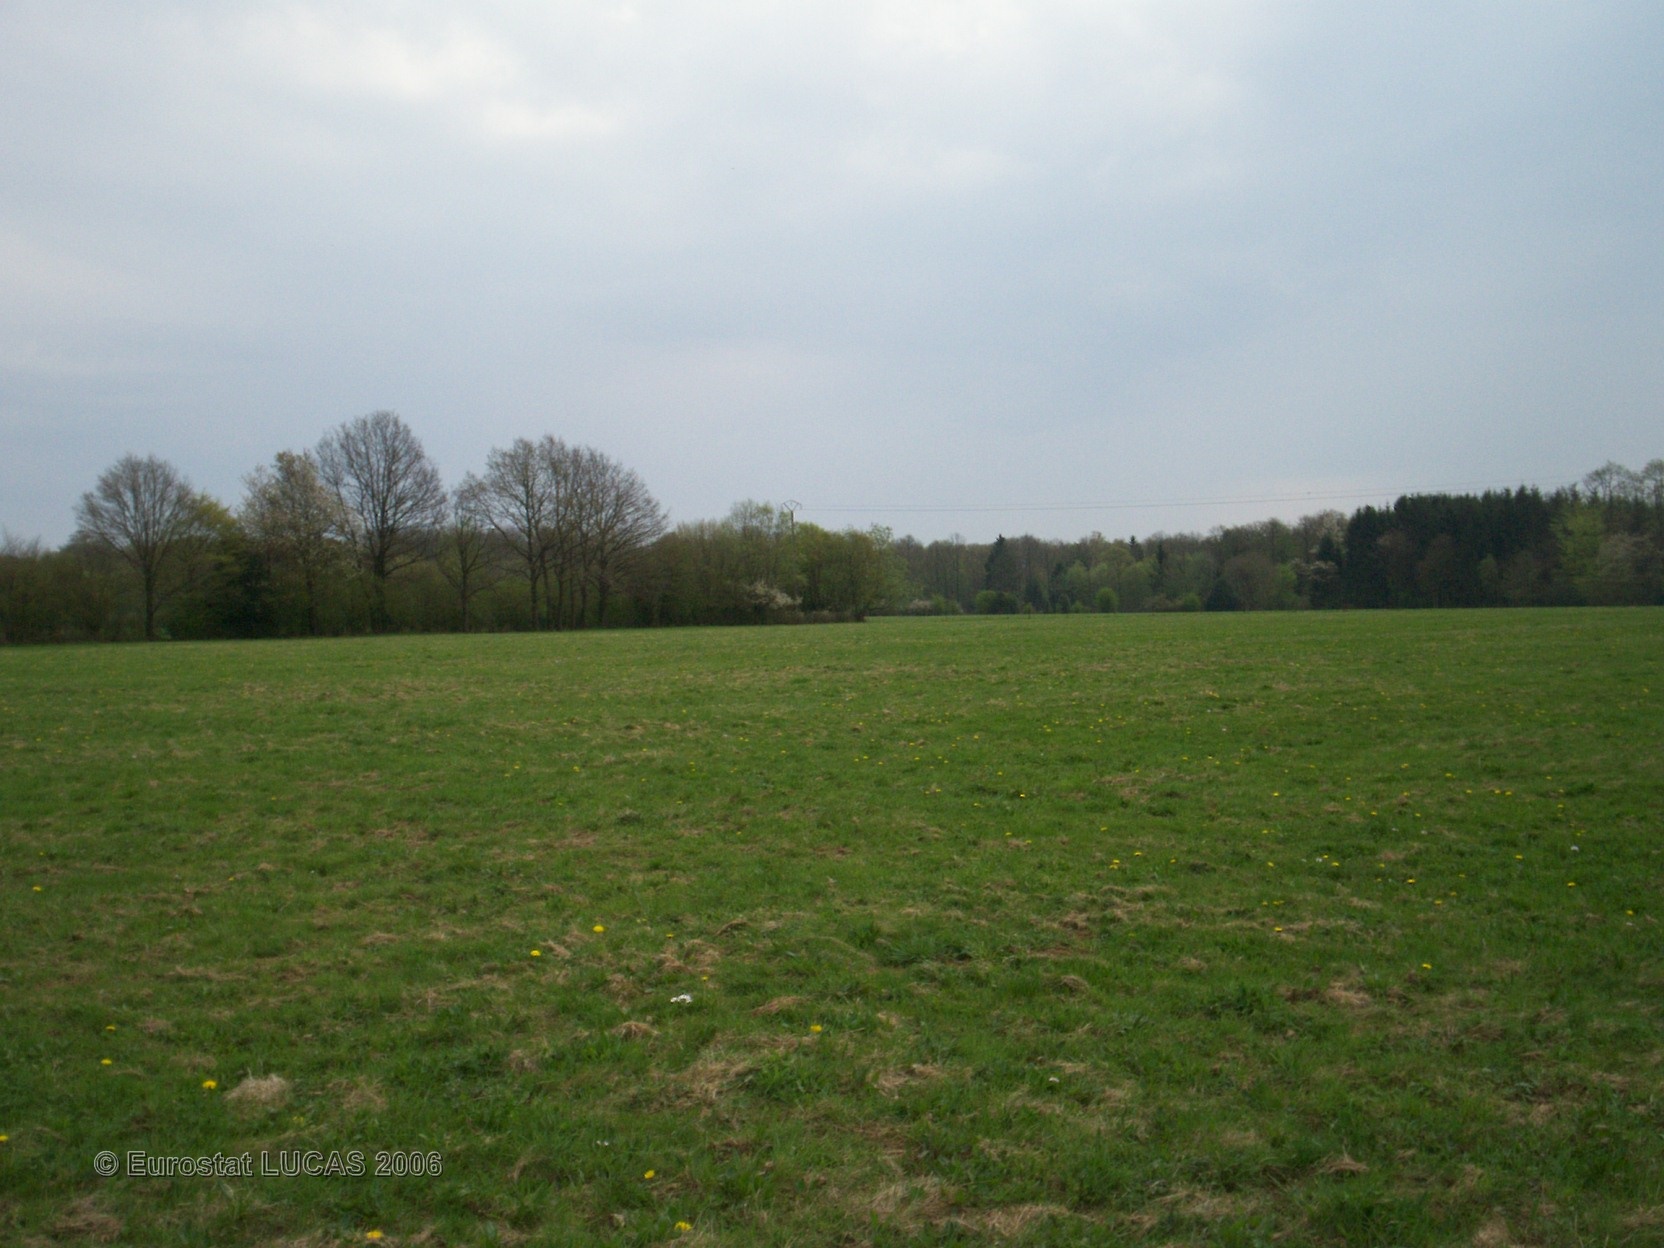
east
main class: Grassland
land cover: Grassland without tree/shrub cover
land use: Agriculture (excluding fallow land and kitchen gardens)
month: May
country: FR
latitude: 49.9334
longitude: 4.2973
